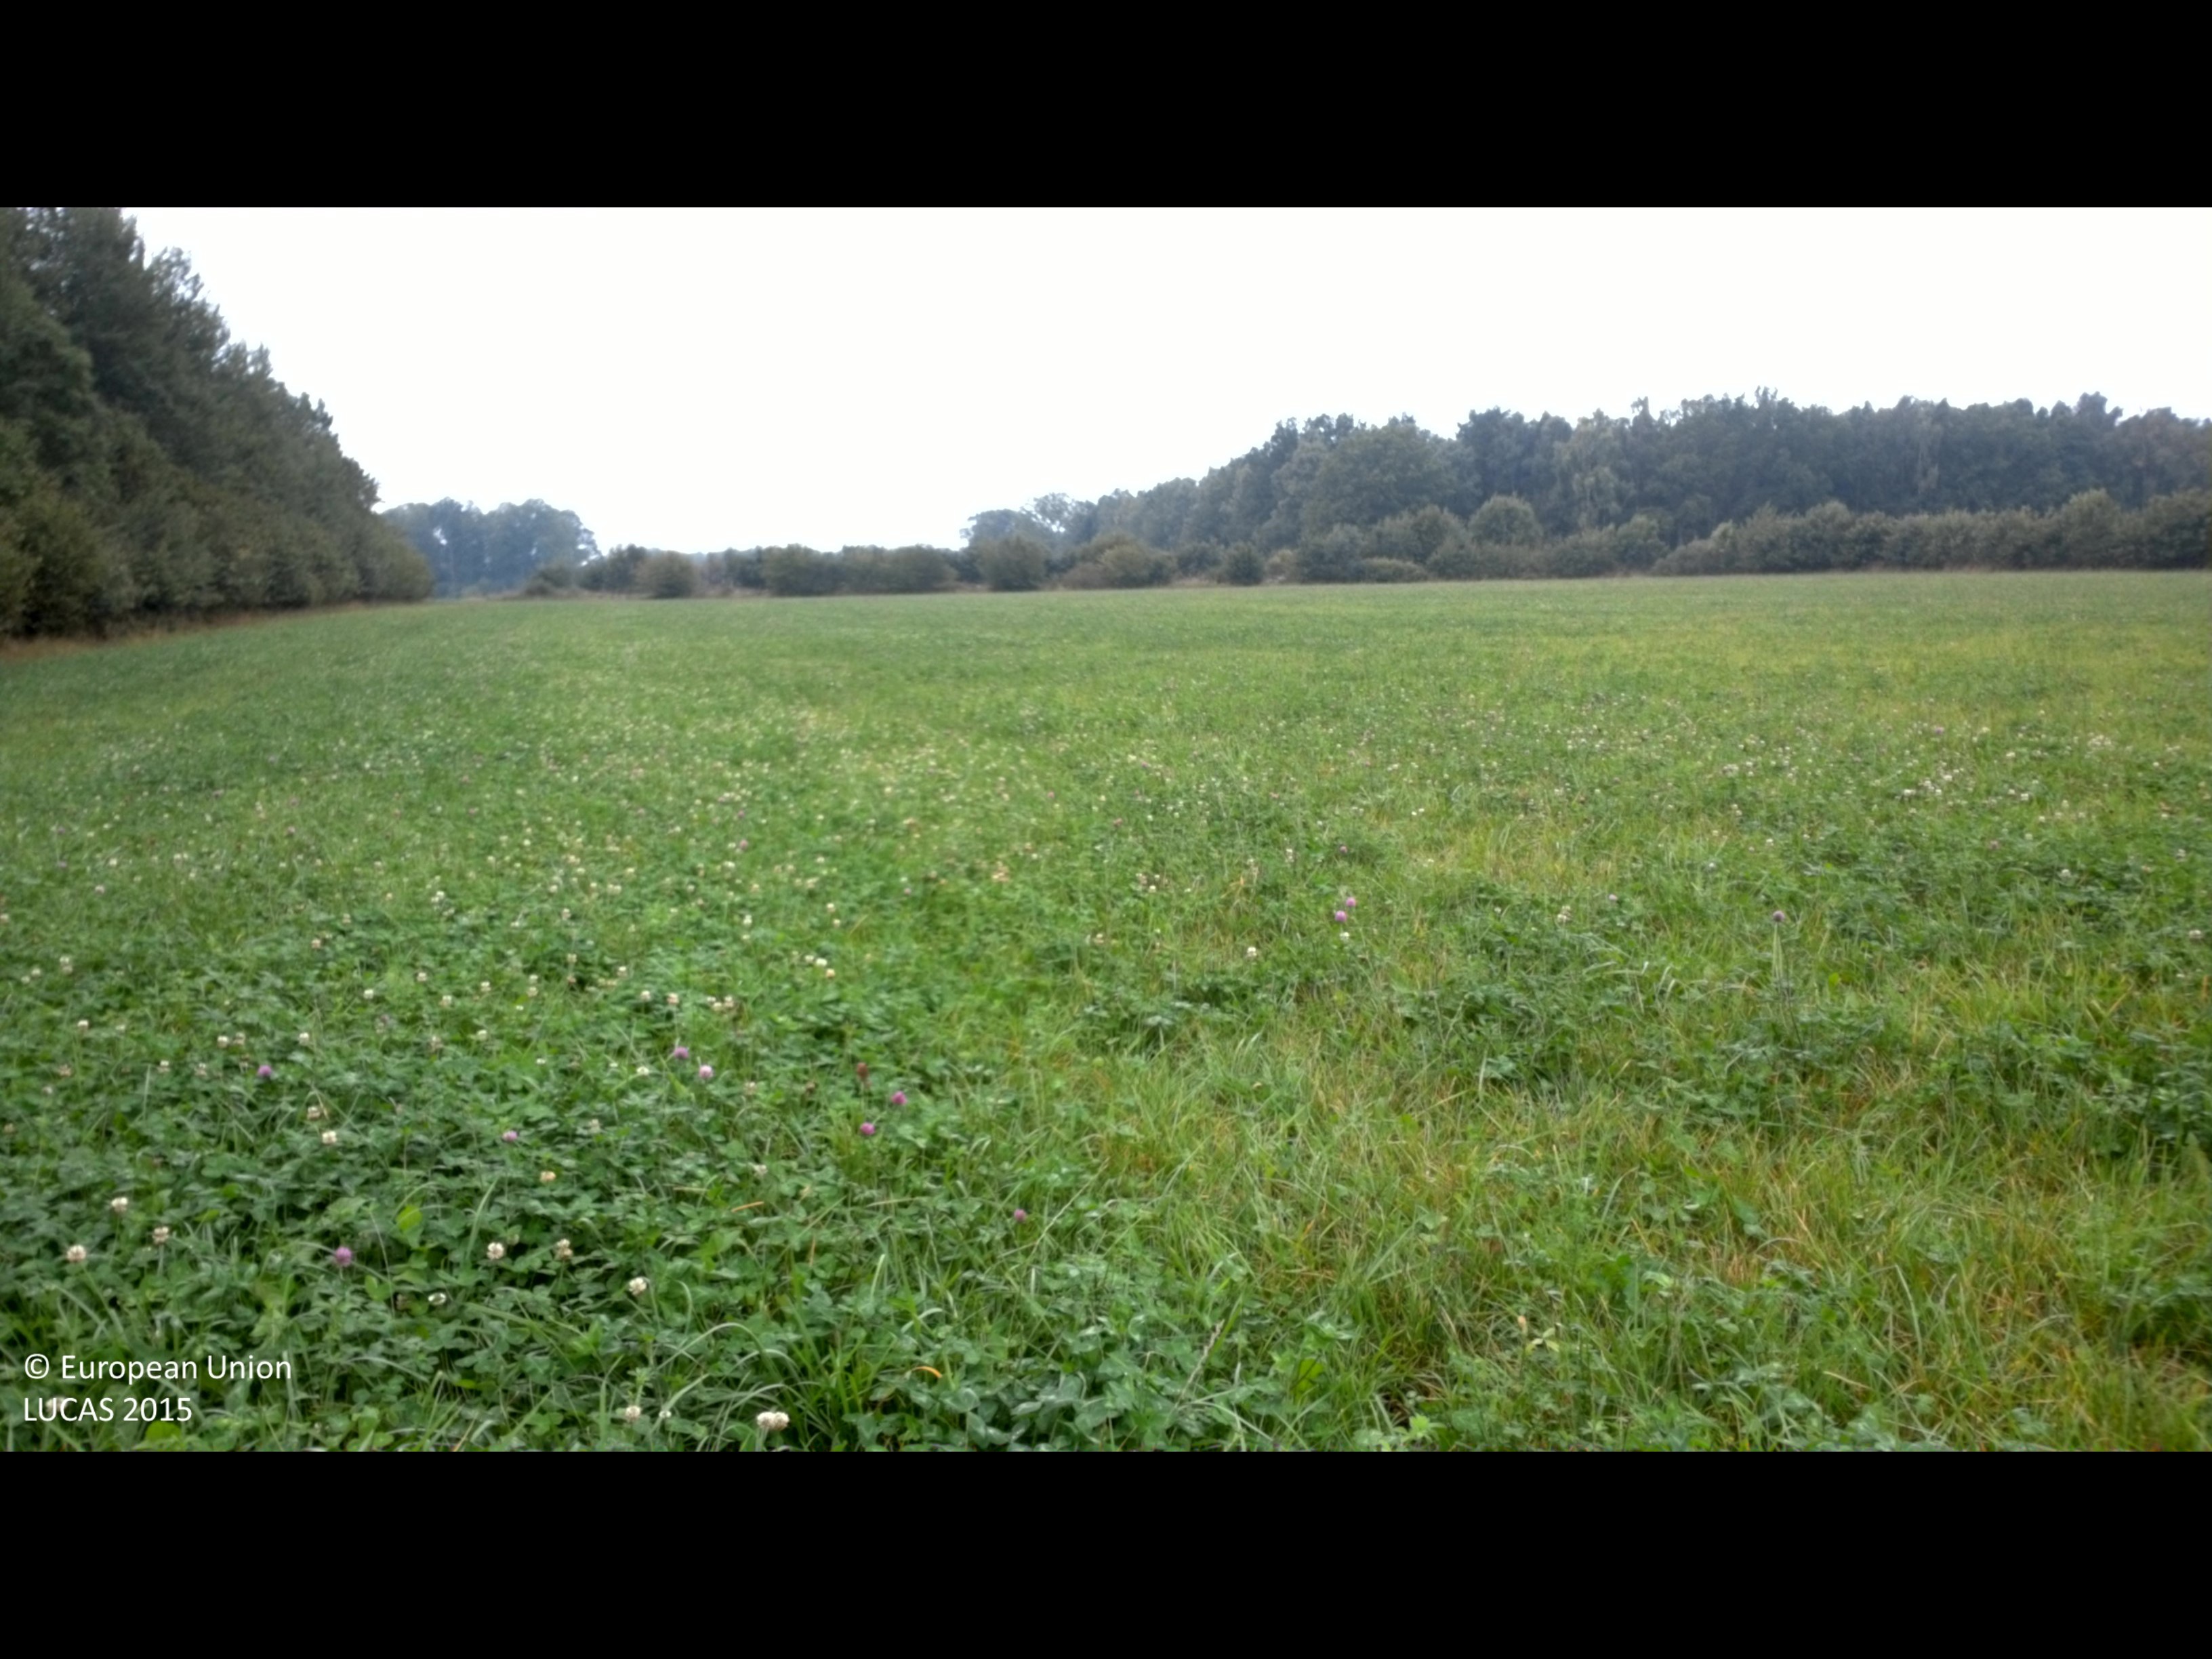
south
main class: Cropland
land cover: Clovers
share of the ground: > 75 %
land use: Agriculture (excluding fallow land and kitchen gardens)
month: September
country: SE
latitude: 55.9629
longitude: 14.0188
